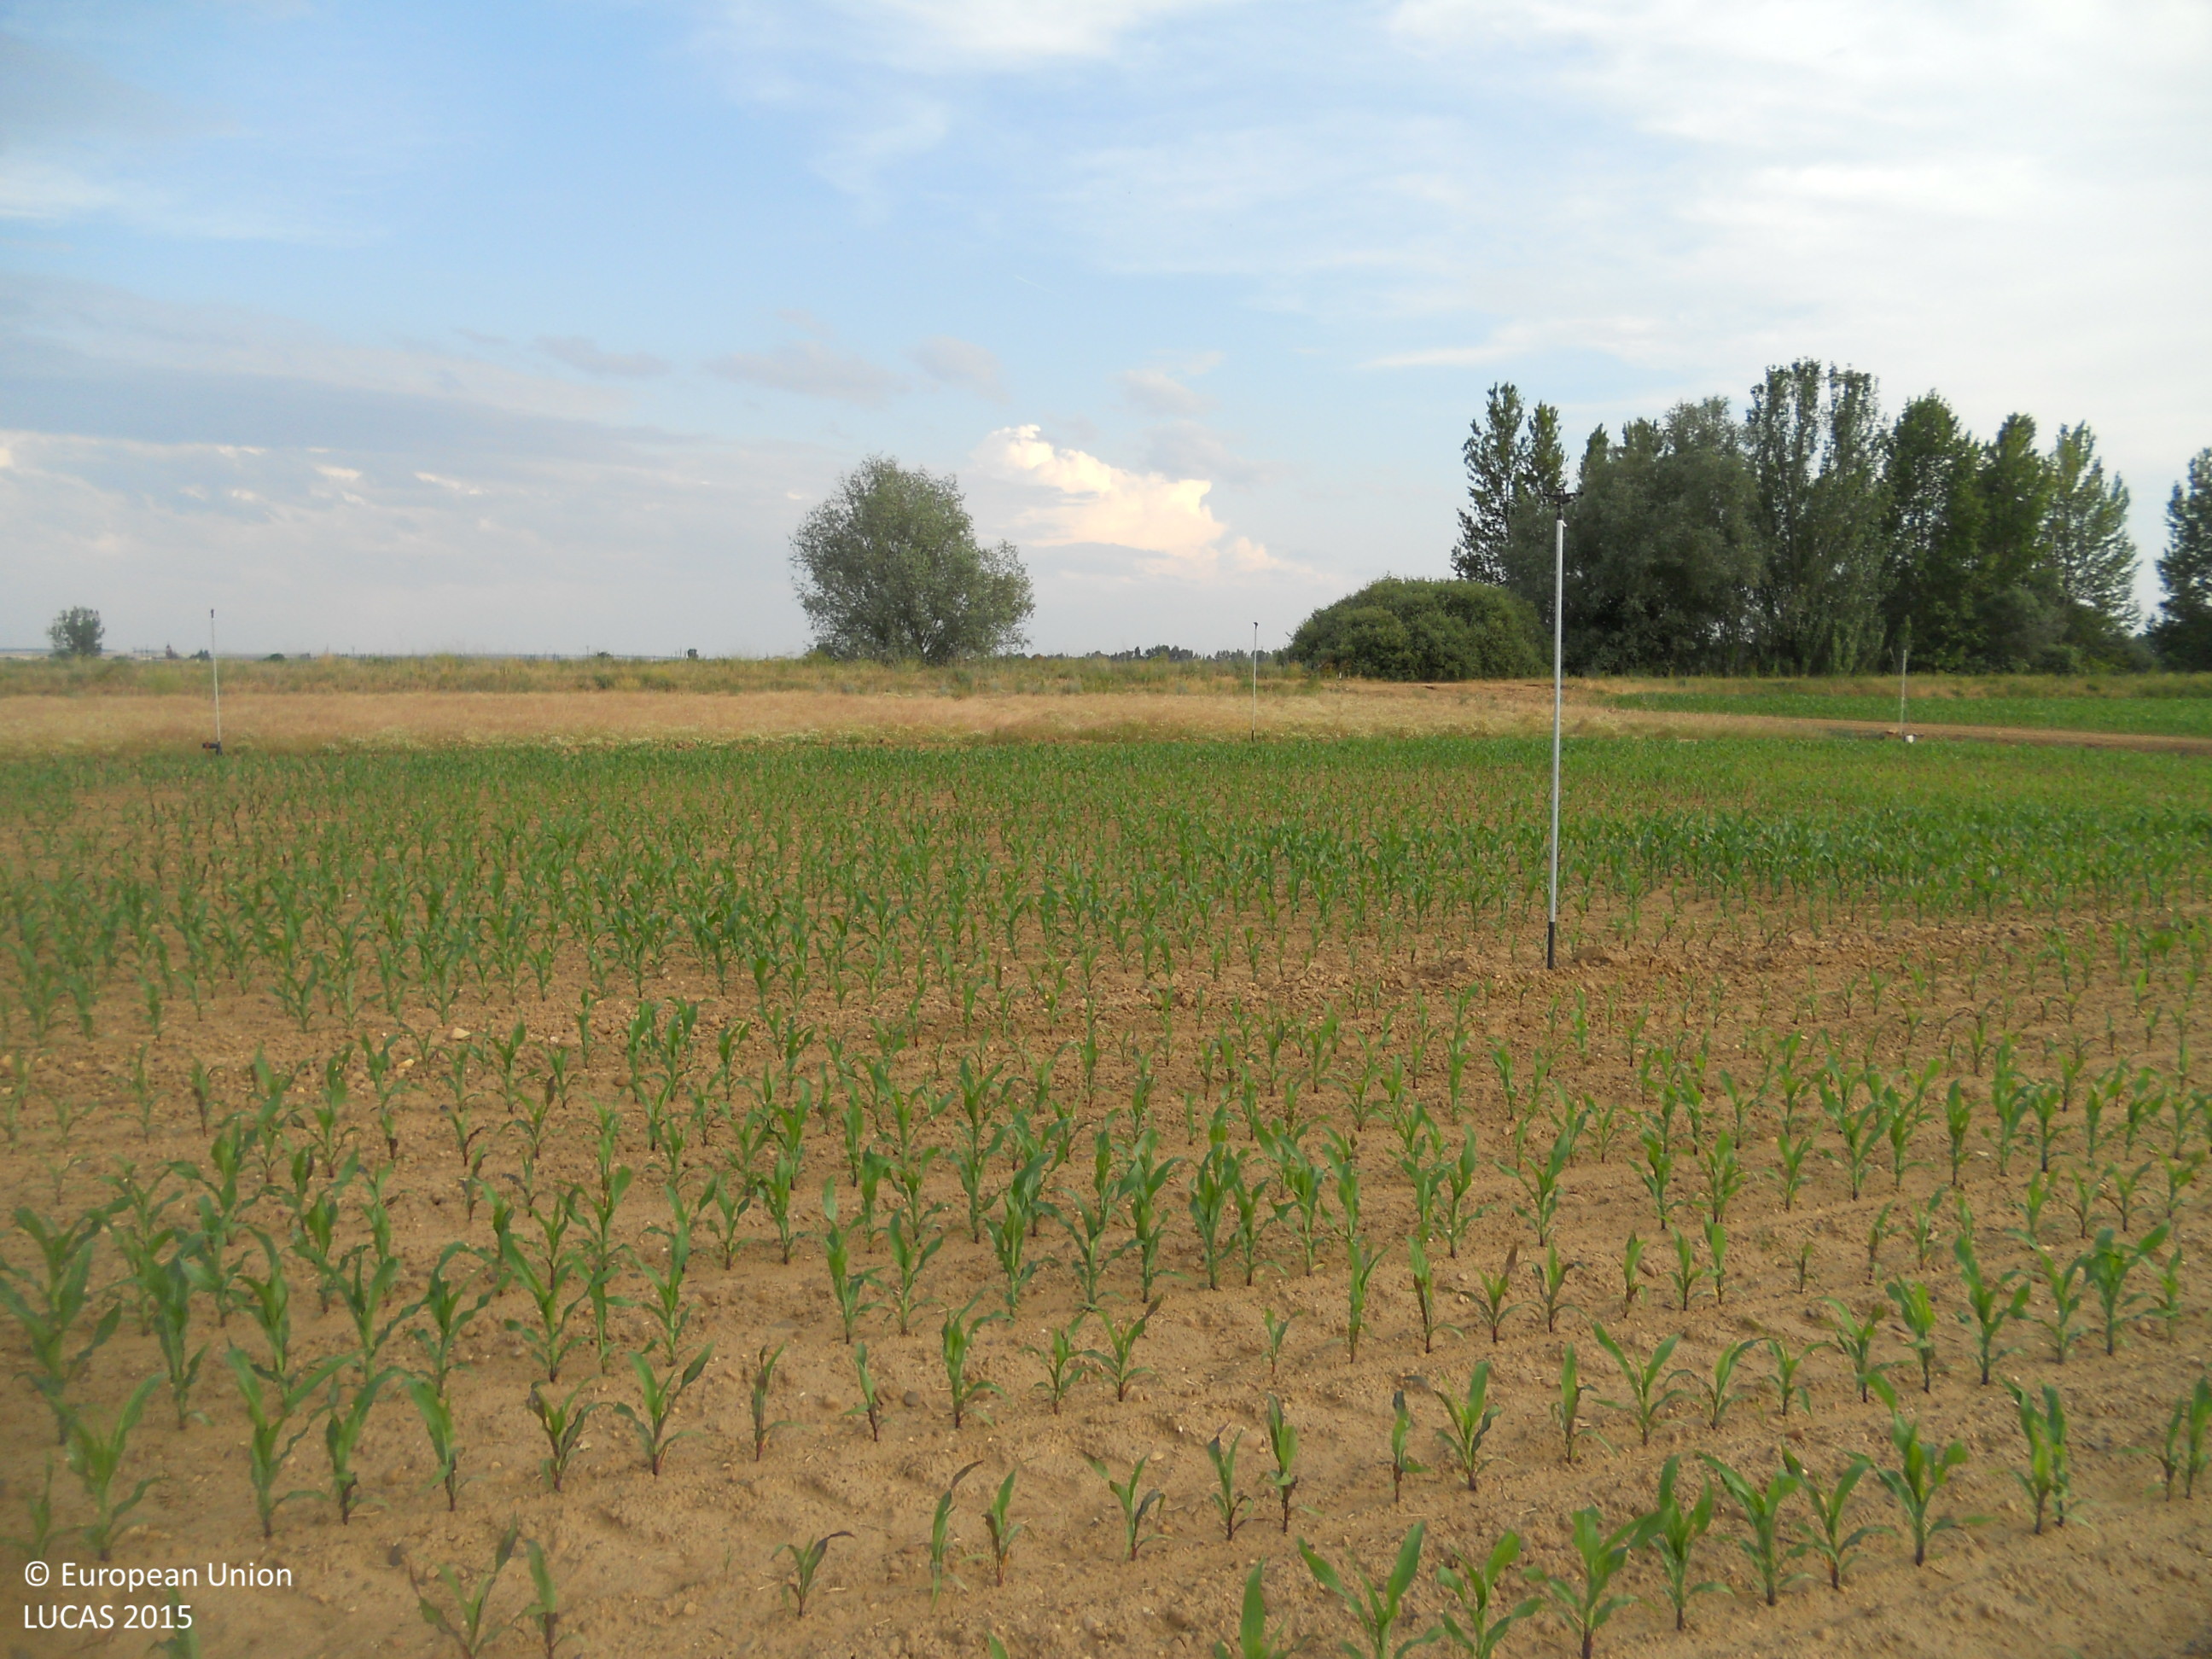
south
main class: Cropland
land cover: Maize
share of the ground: < 10 %
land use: Agriculture (excluding fallow land and kitchen gardens)
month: June
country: ES
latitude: 42.3623
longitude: -5.5504
